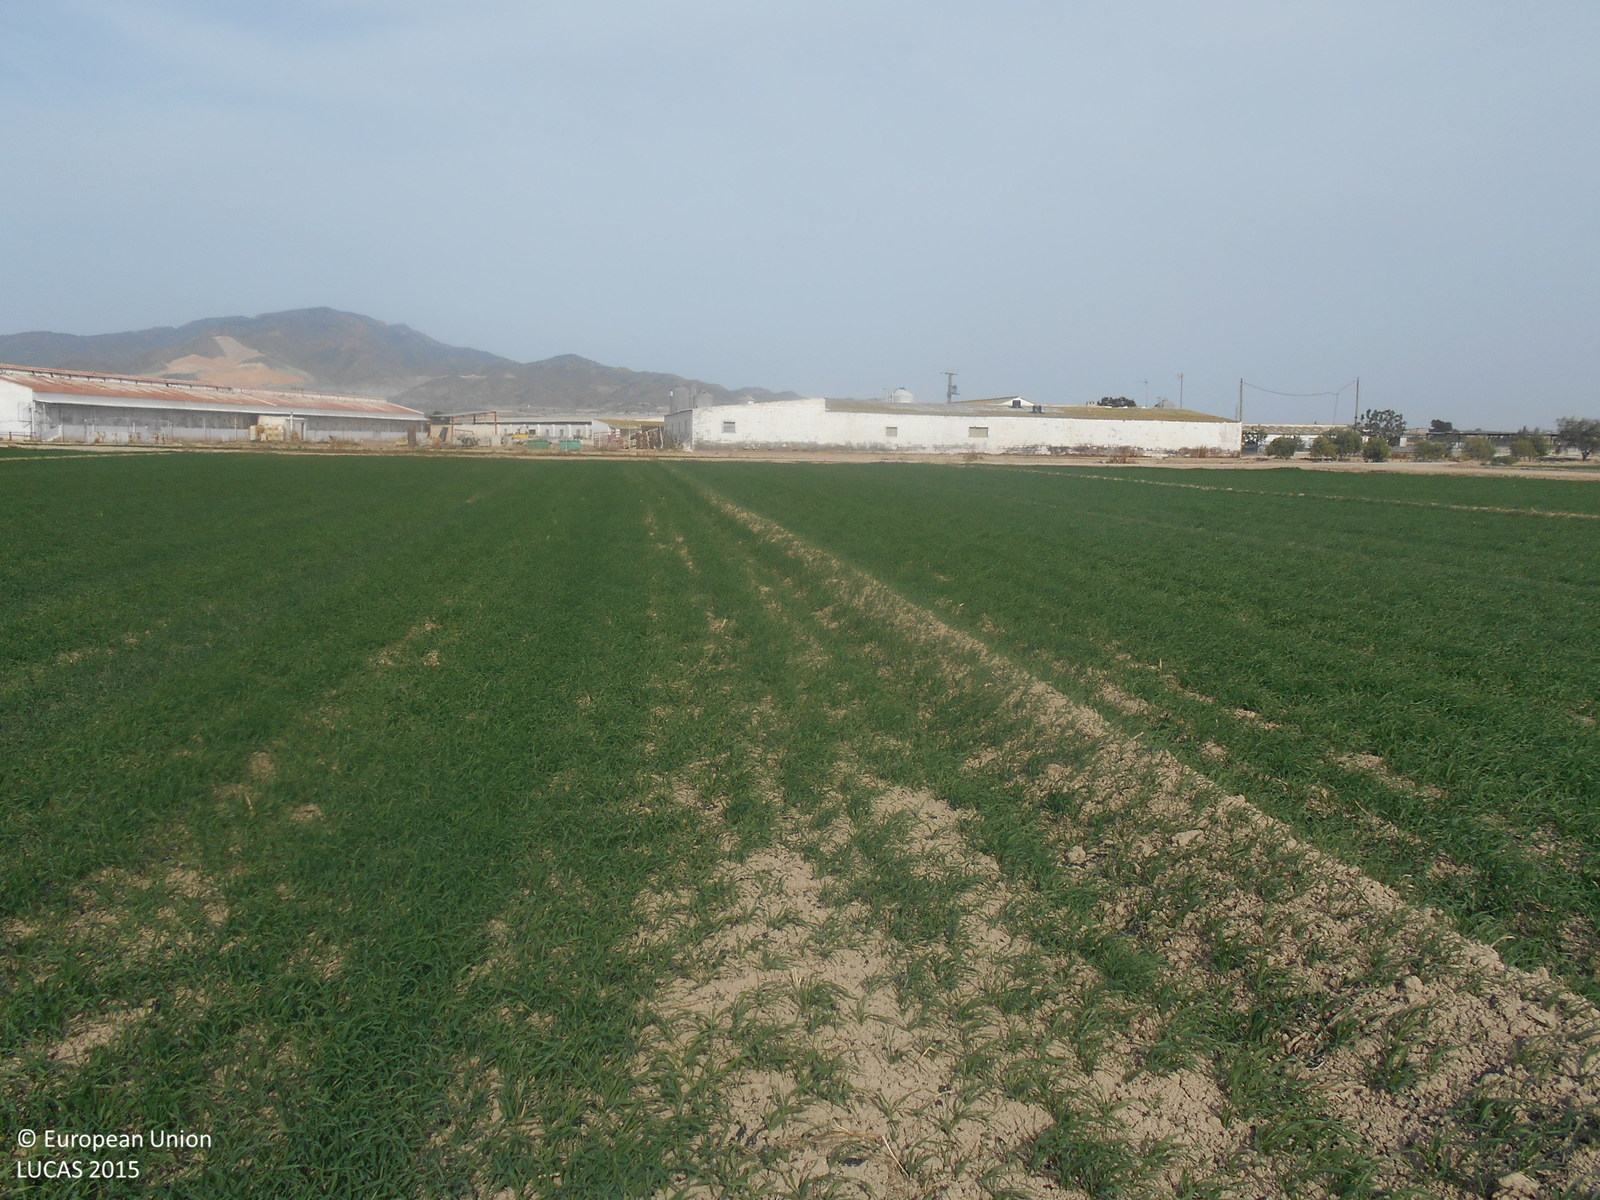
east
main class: Cropland
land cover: Barley
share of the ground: > 75 %
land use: Agriculture (excluding fallow land and kitchen gardens)
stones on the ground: < 10 %
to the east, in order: Barley; Paved roads, cycling and walking lanes; Barley; Ditches and canals; Tracks; Artificial constructions in urban areas; Tracks; Barley
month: April
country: ES
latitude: 37.7920
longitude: -1.3953
